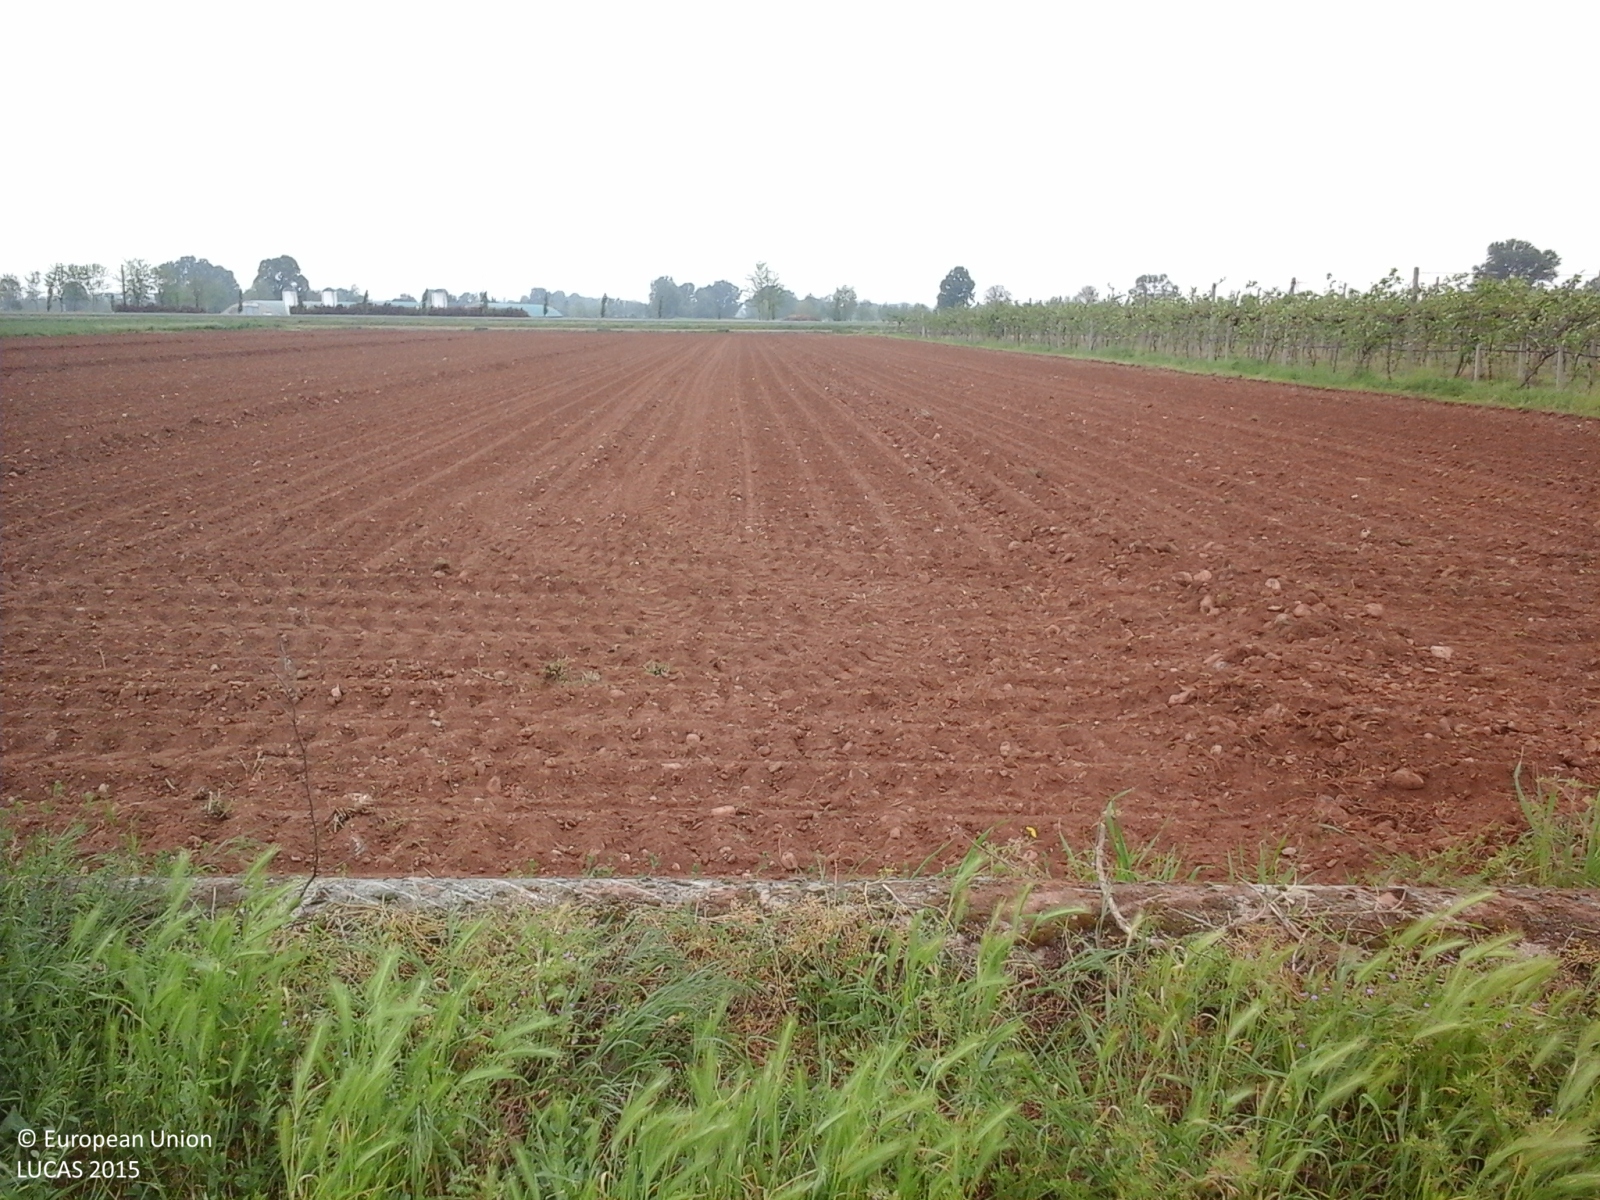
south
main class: Cropland
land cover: Maize
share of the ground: < 10 %
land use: Agriculture (excluding fallow land and kitchen gardens)
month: April
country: IT
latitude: 45.3223
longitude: 10.6240
